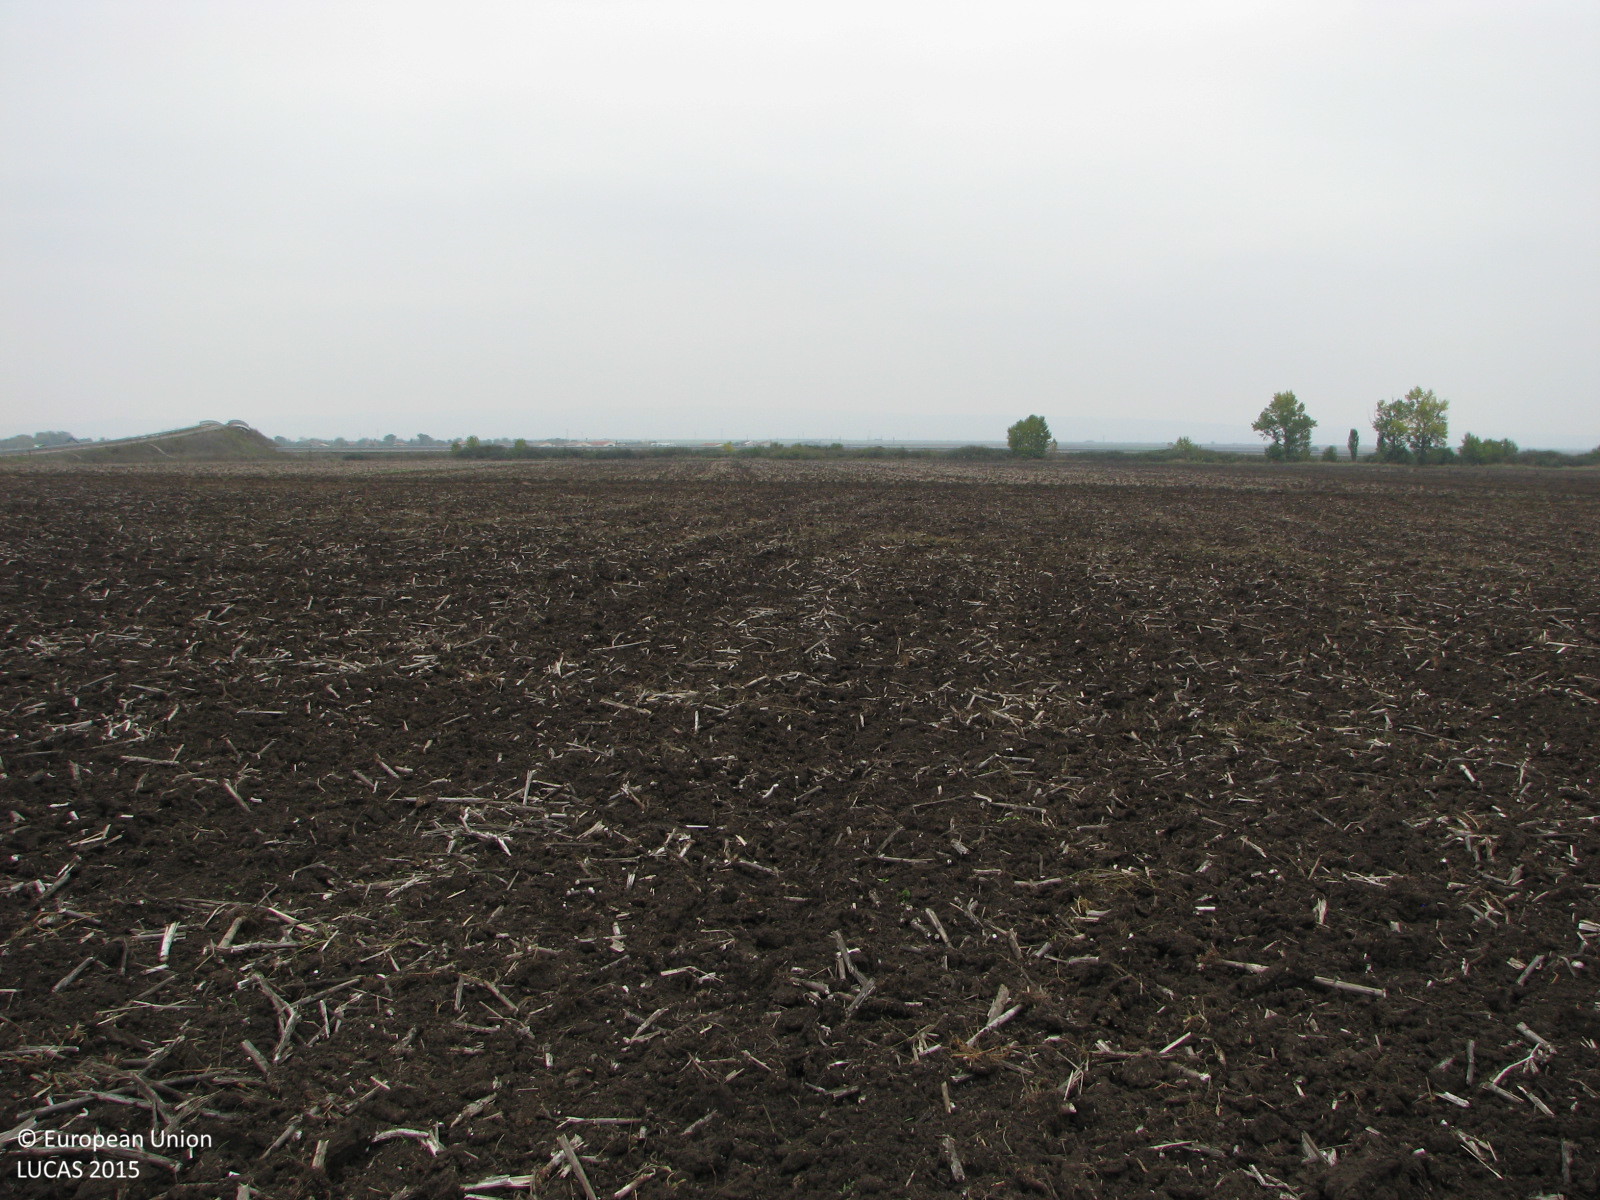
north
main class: Cropland
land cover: Rape and turnip rape
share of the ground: < 10 %
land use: Agriculture (excluding fallow land and kitchen gardens)
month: October
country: BG
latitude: 42.5465
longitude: 26.7955
